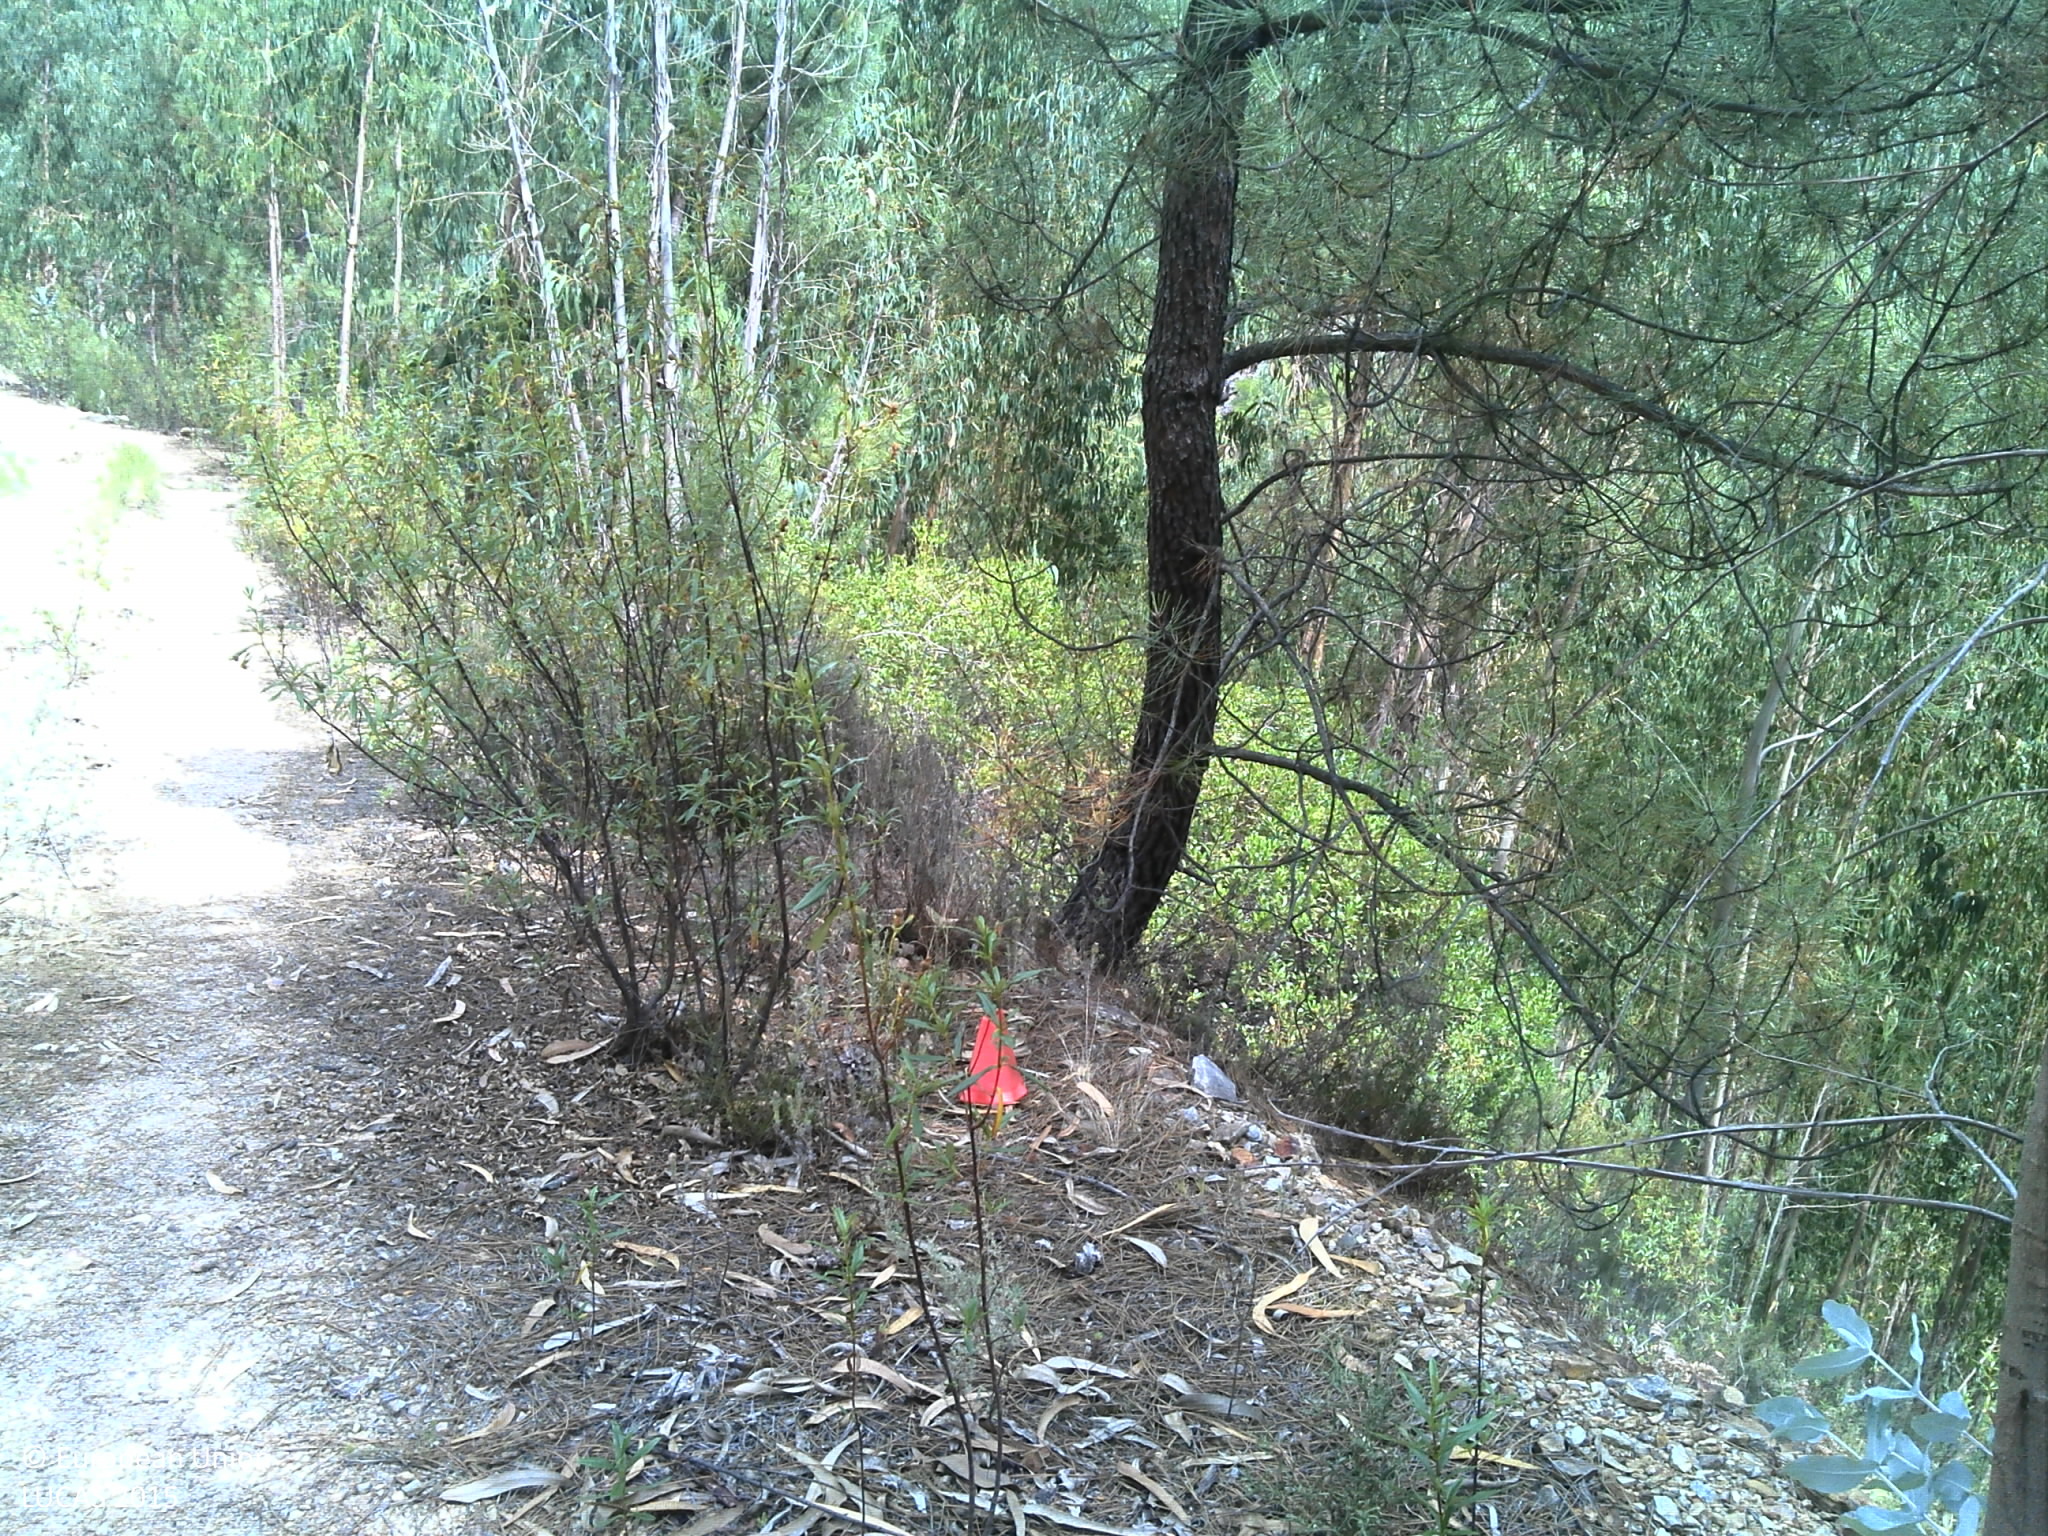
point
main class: Woodland
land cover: Pine dominated mixed woodland
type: coniferous forest of the mediterranean region
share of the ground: 25 - 50 %
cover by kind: shrubs 30 %, unconsolidated bare surface 25 %, consolidated bare surface 20 %, broadleaved forest trees 15 %, coniferous forest trees 10 %
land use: Forestry
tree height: > 5 m
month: July
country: PT
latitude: 39.6153
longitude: -8.0354
